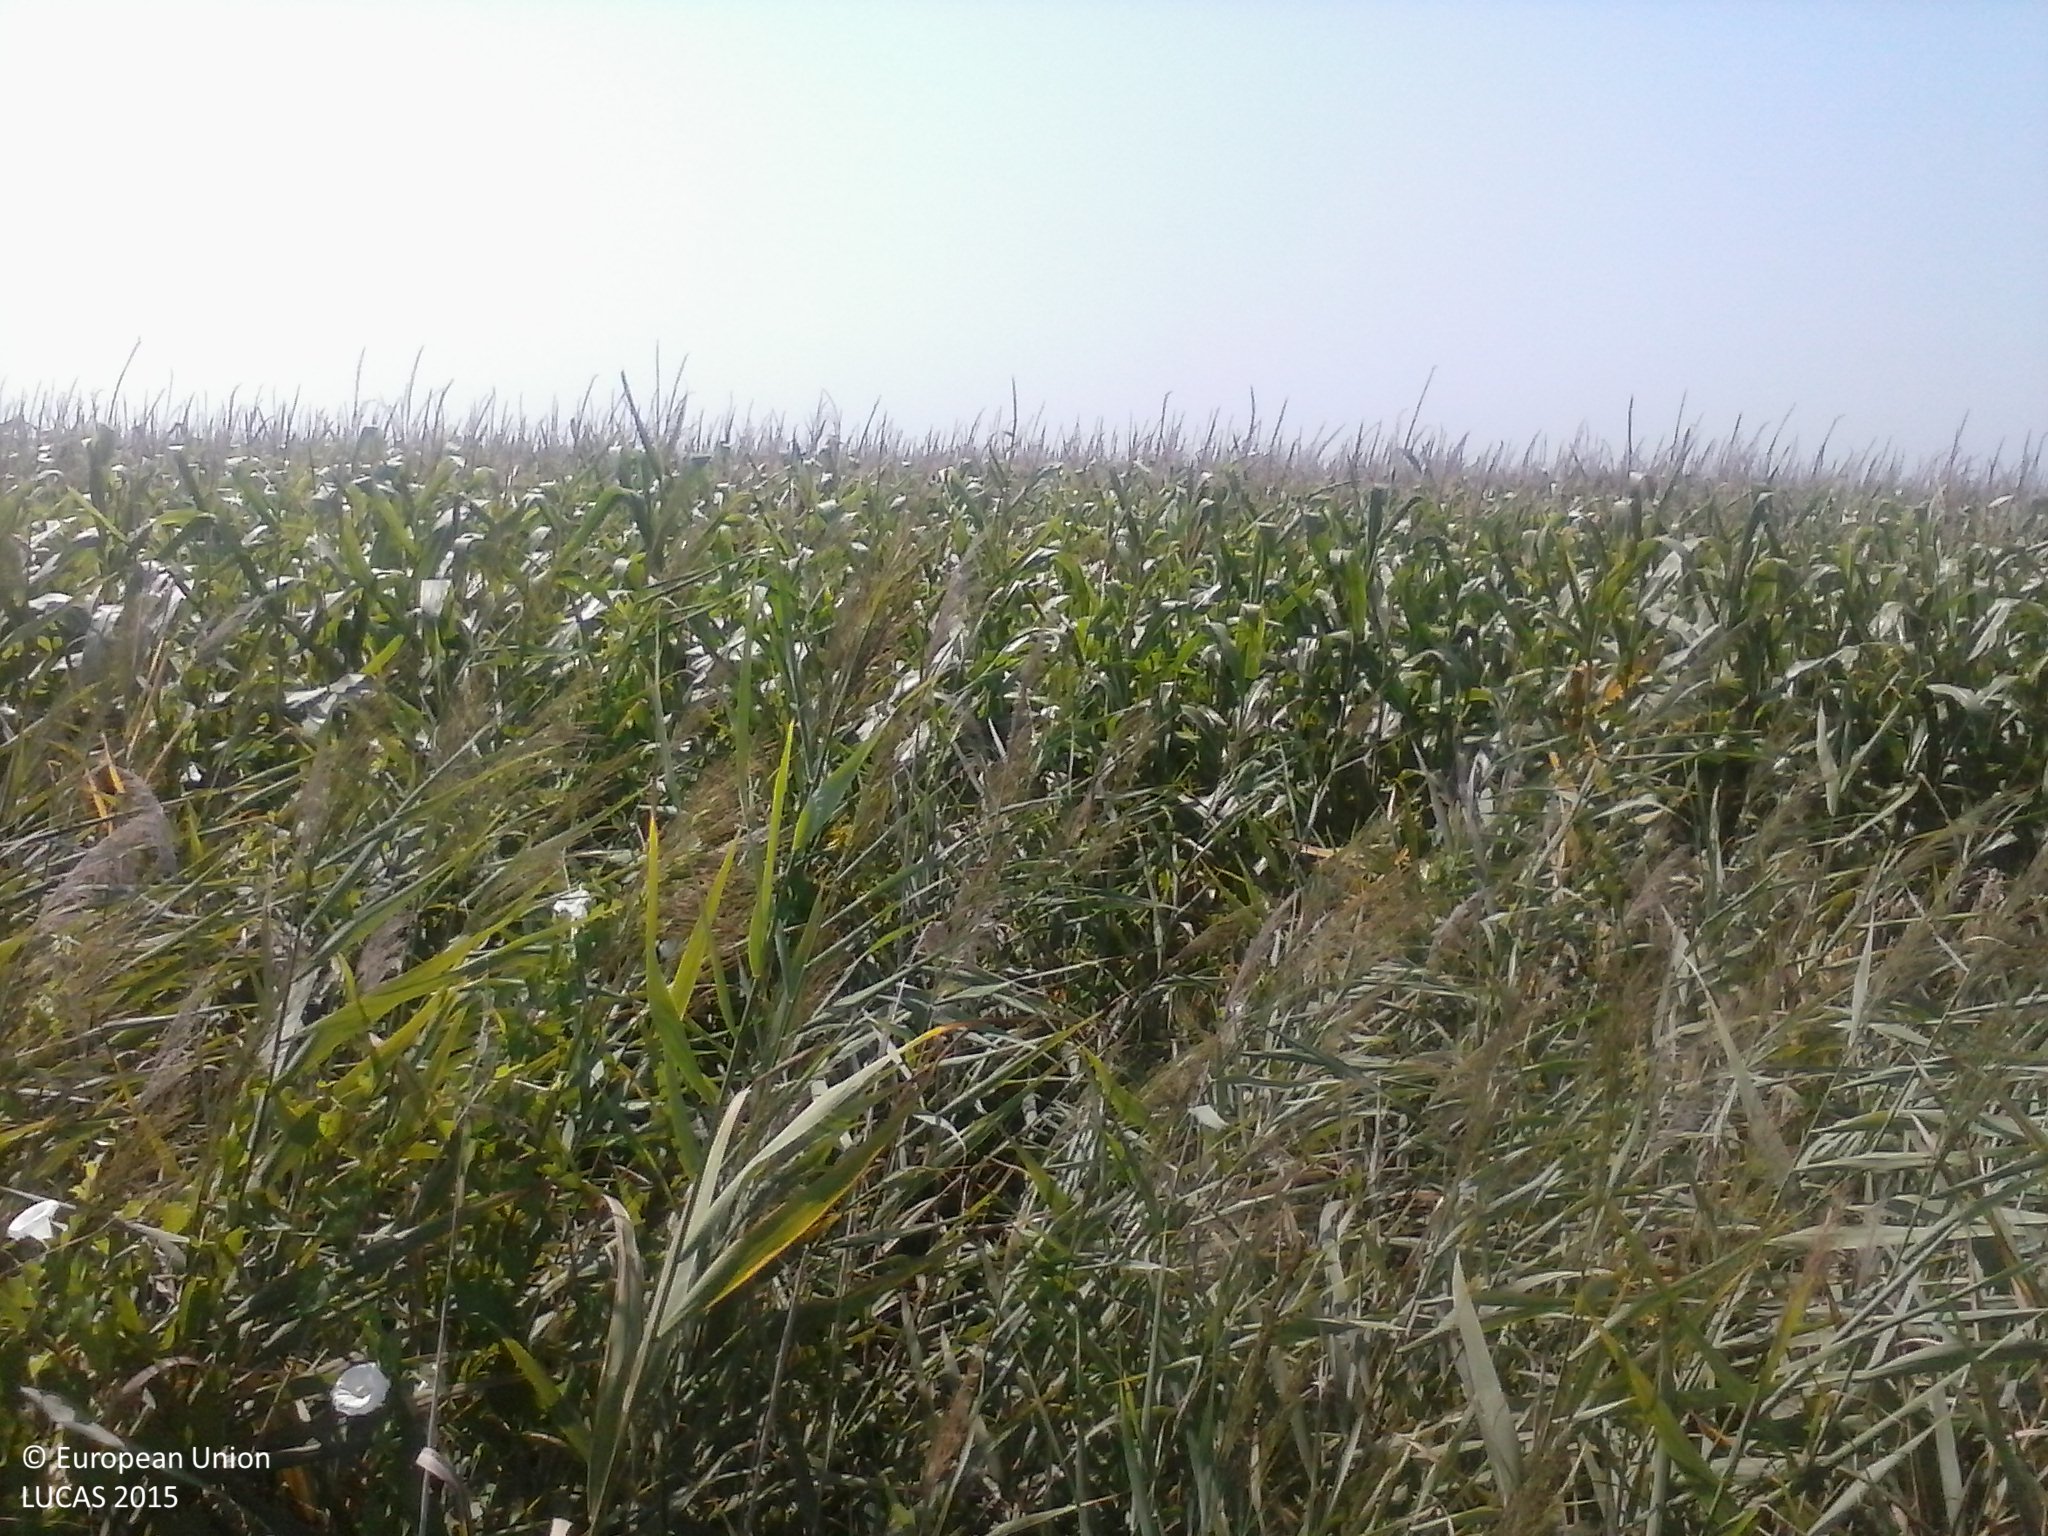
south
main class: Cropland
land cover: Maize
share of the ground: > 75 %
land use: Agriculture (excluding fallow land and kitchen gardens)
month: August
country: HU
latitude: 45.9313
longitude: 17.9105
